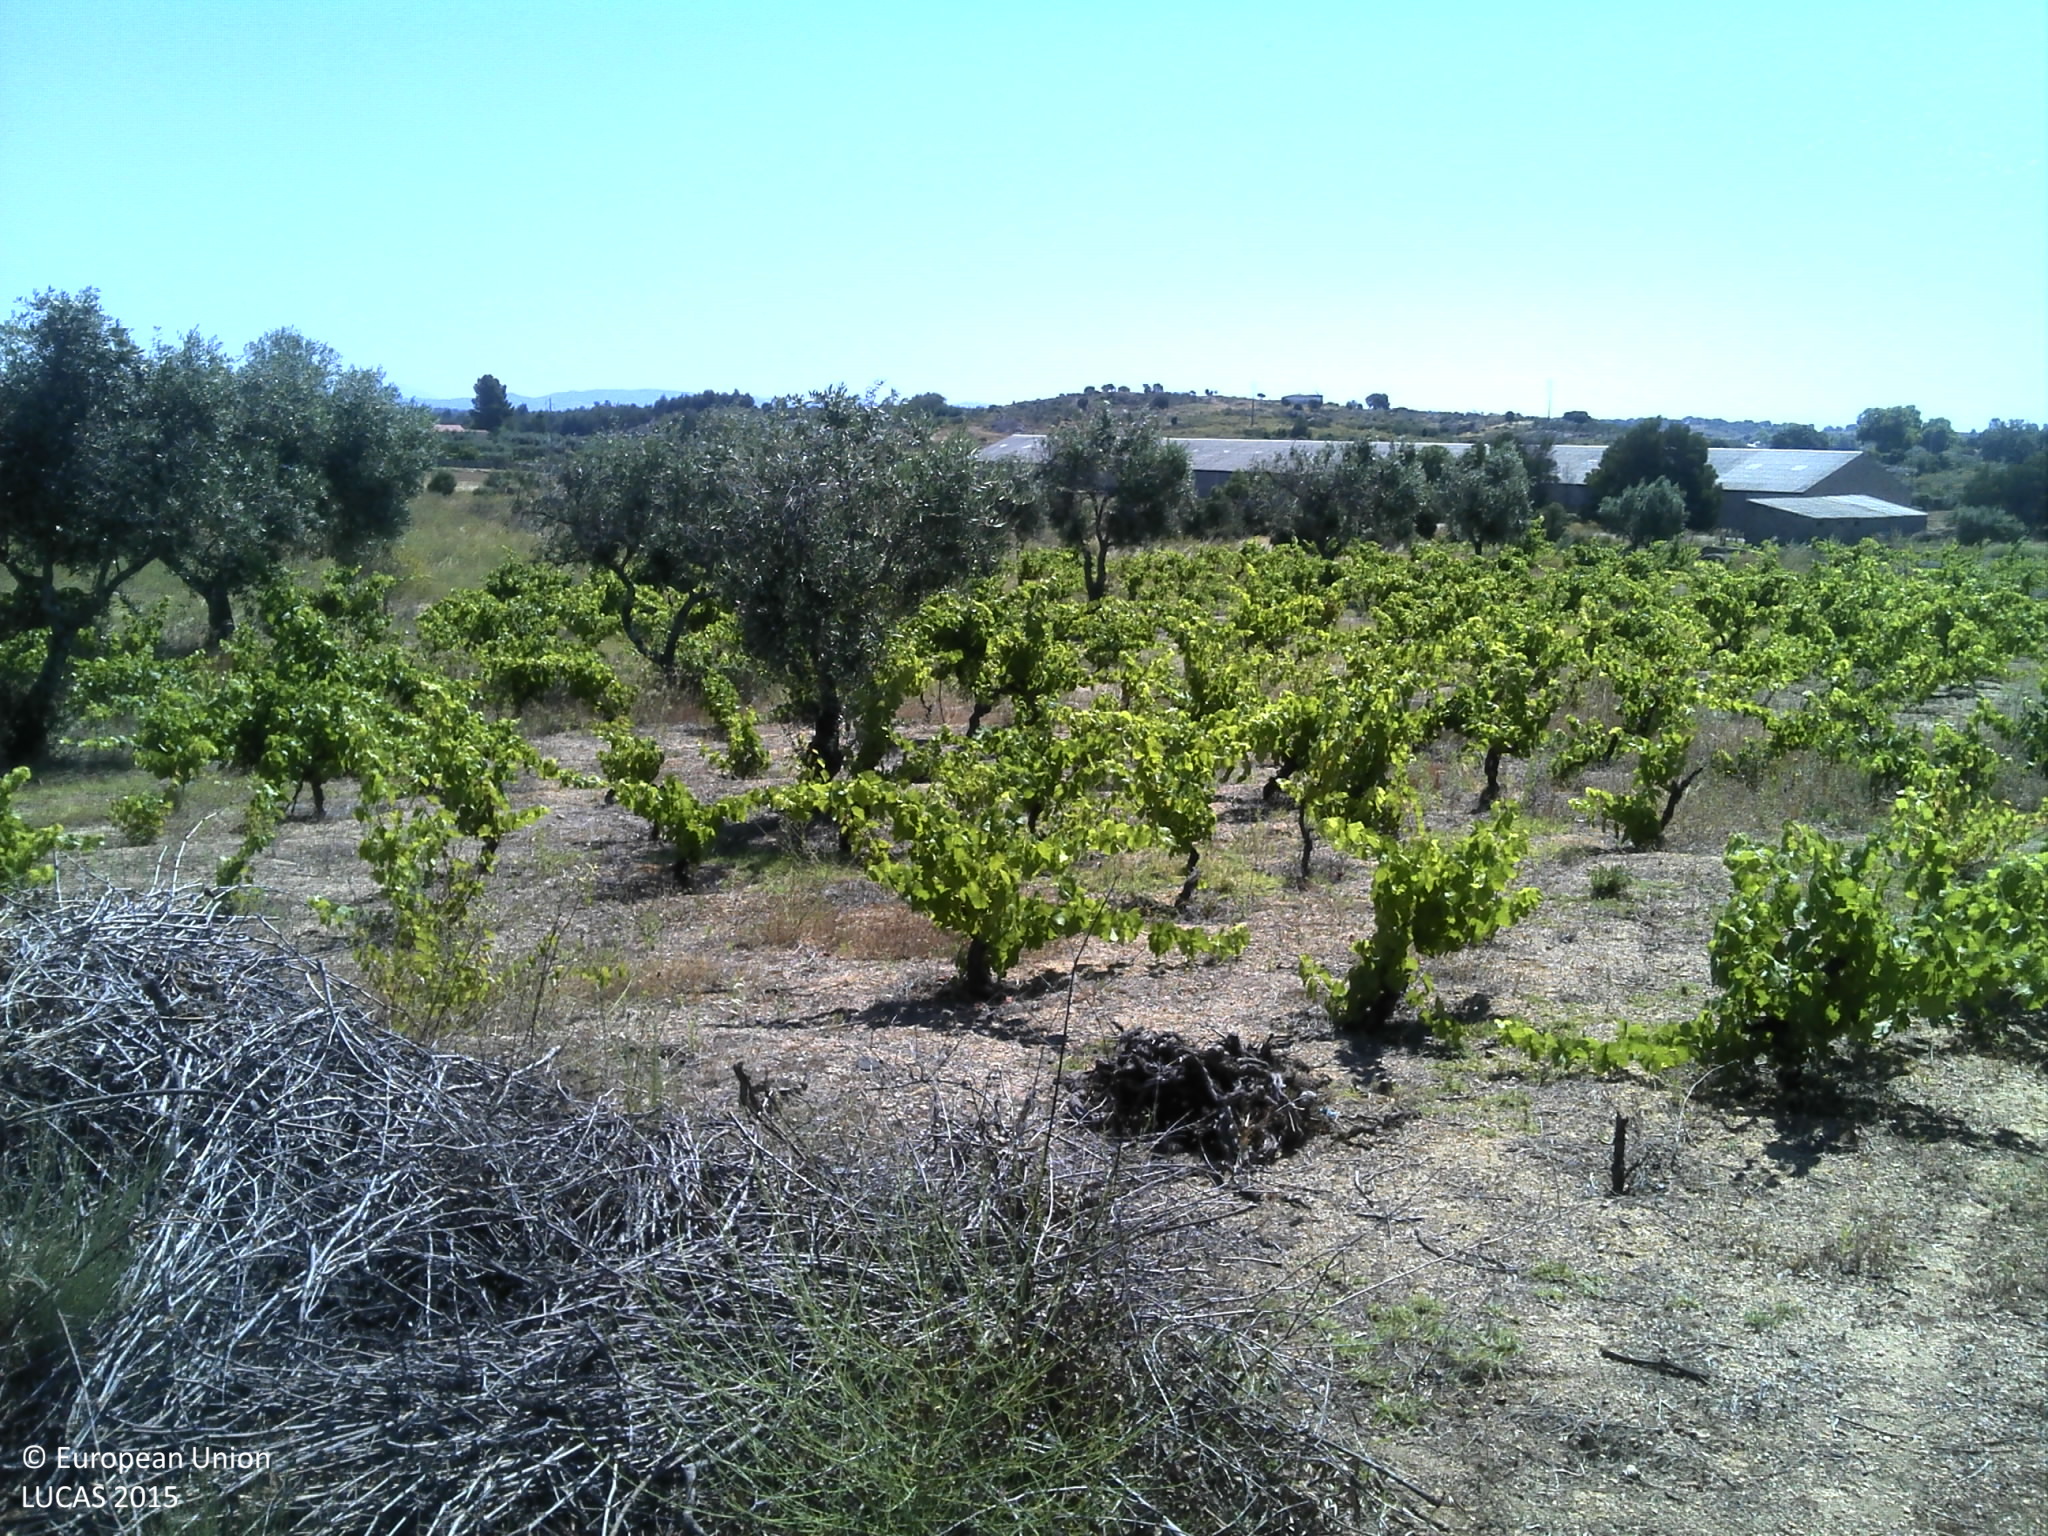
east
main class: Cropland
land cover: Olive groves
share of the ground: 25 - 50 %
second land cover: Grassland without tree/shrub cover
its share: 50 - 75 %
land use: Agriculture (excluding fallow land and kitchen gardens)
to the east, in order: Olive groves; Grassland without tree/shrub cover; Olive groves; Fences; Olive groves; Fences; Vineyards; Rock outcrops; Vineyards; Artificial constructions in urban areas; Rock outcrops; Artificial constructions in urban areas; Shrubland without tree cover; Artificial constructions in urban areas; Grassland without tree/shrub cover
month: June
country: PT
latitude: 40.0252
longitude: -7.3113
